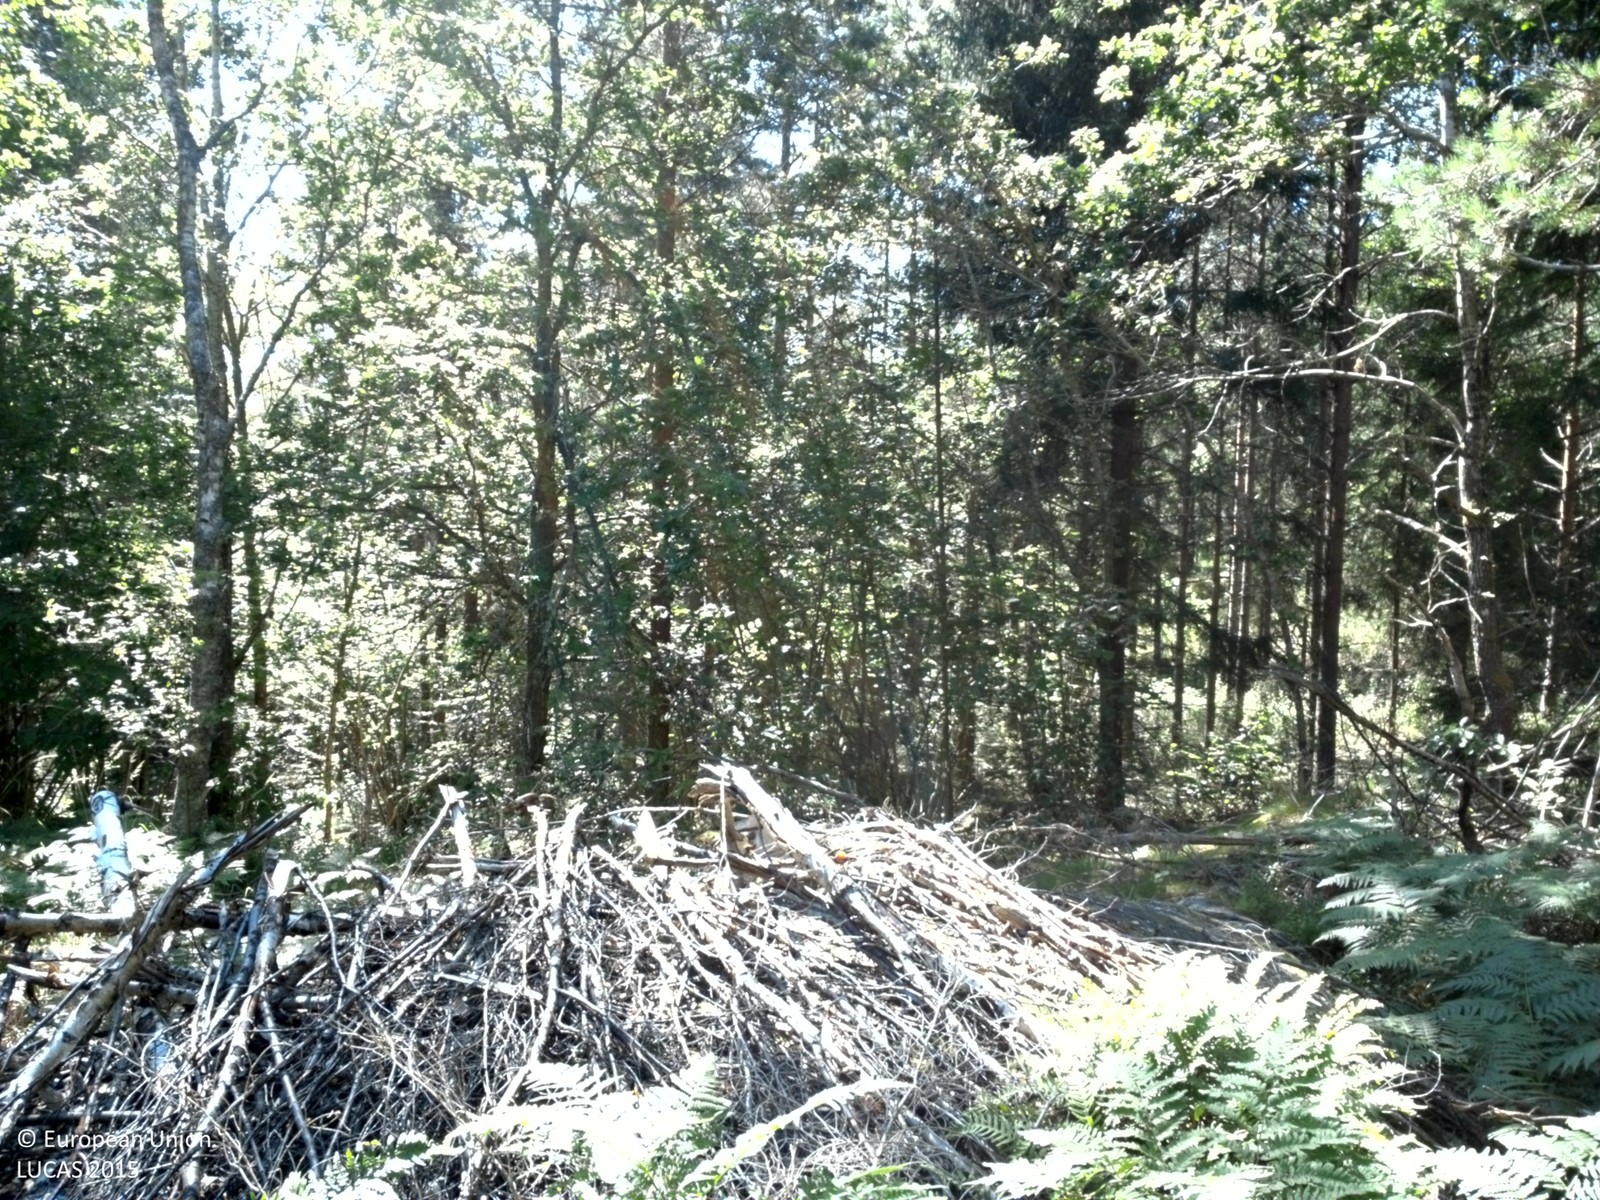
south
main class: Woodland
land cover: Spruce dominated mixed woodland
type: boreal forest
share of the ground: 25 - 50 %
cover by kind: herbaceous plants 40 %, coniferous forest trees 30 %, broadleaved forest trees 20 %, consolidated bare surface 10 %
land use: Forestry
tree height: > 5 m
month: August
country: SE
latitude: 59.5537
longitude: 18.3321
